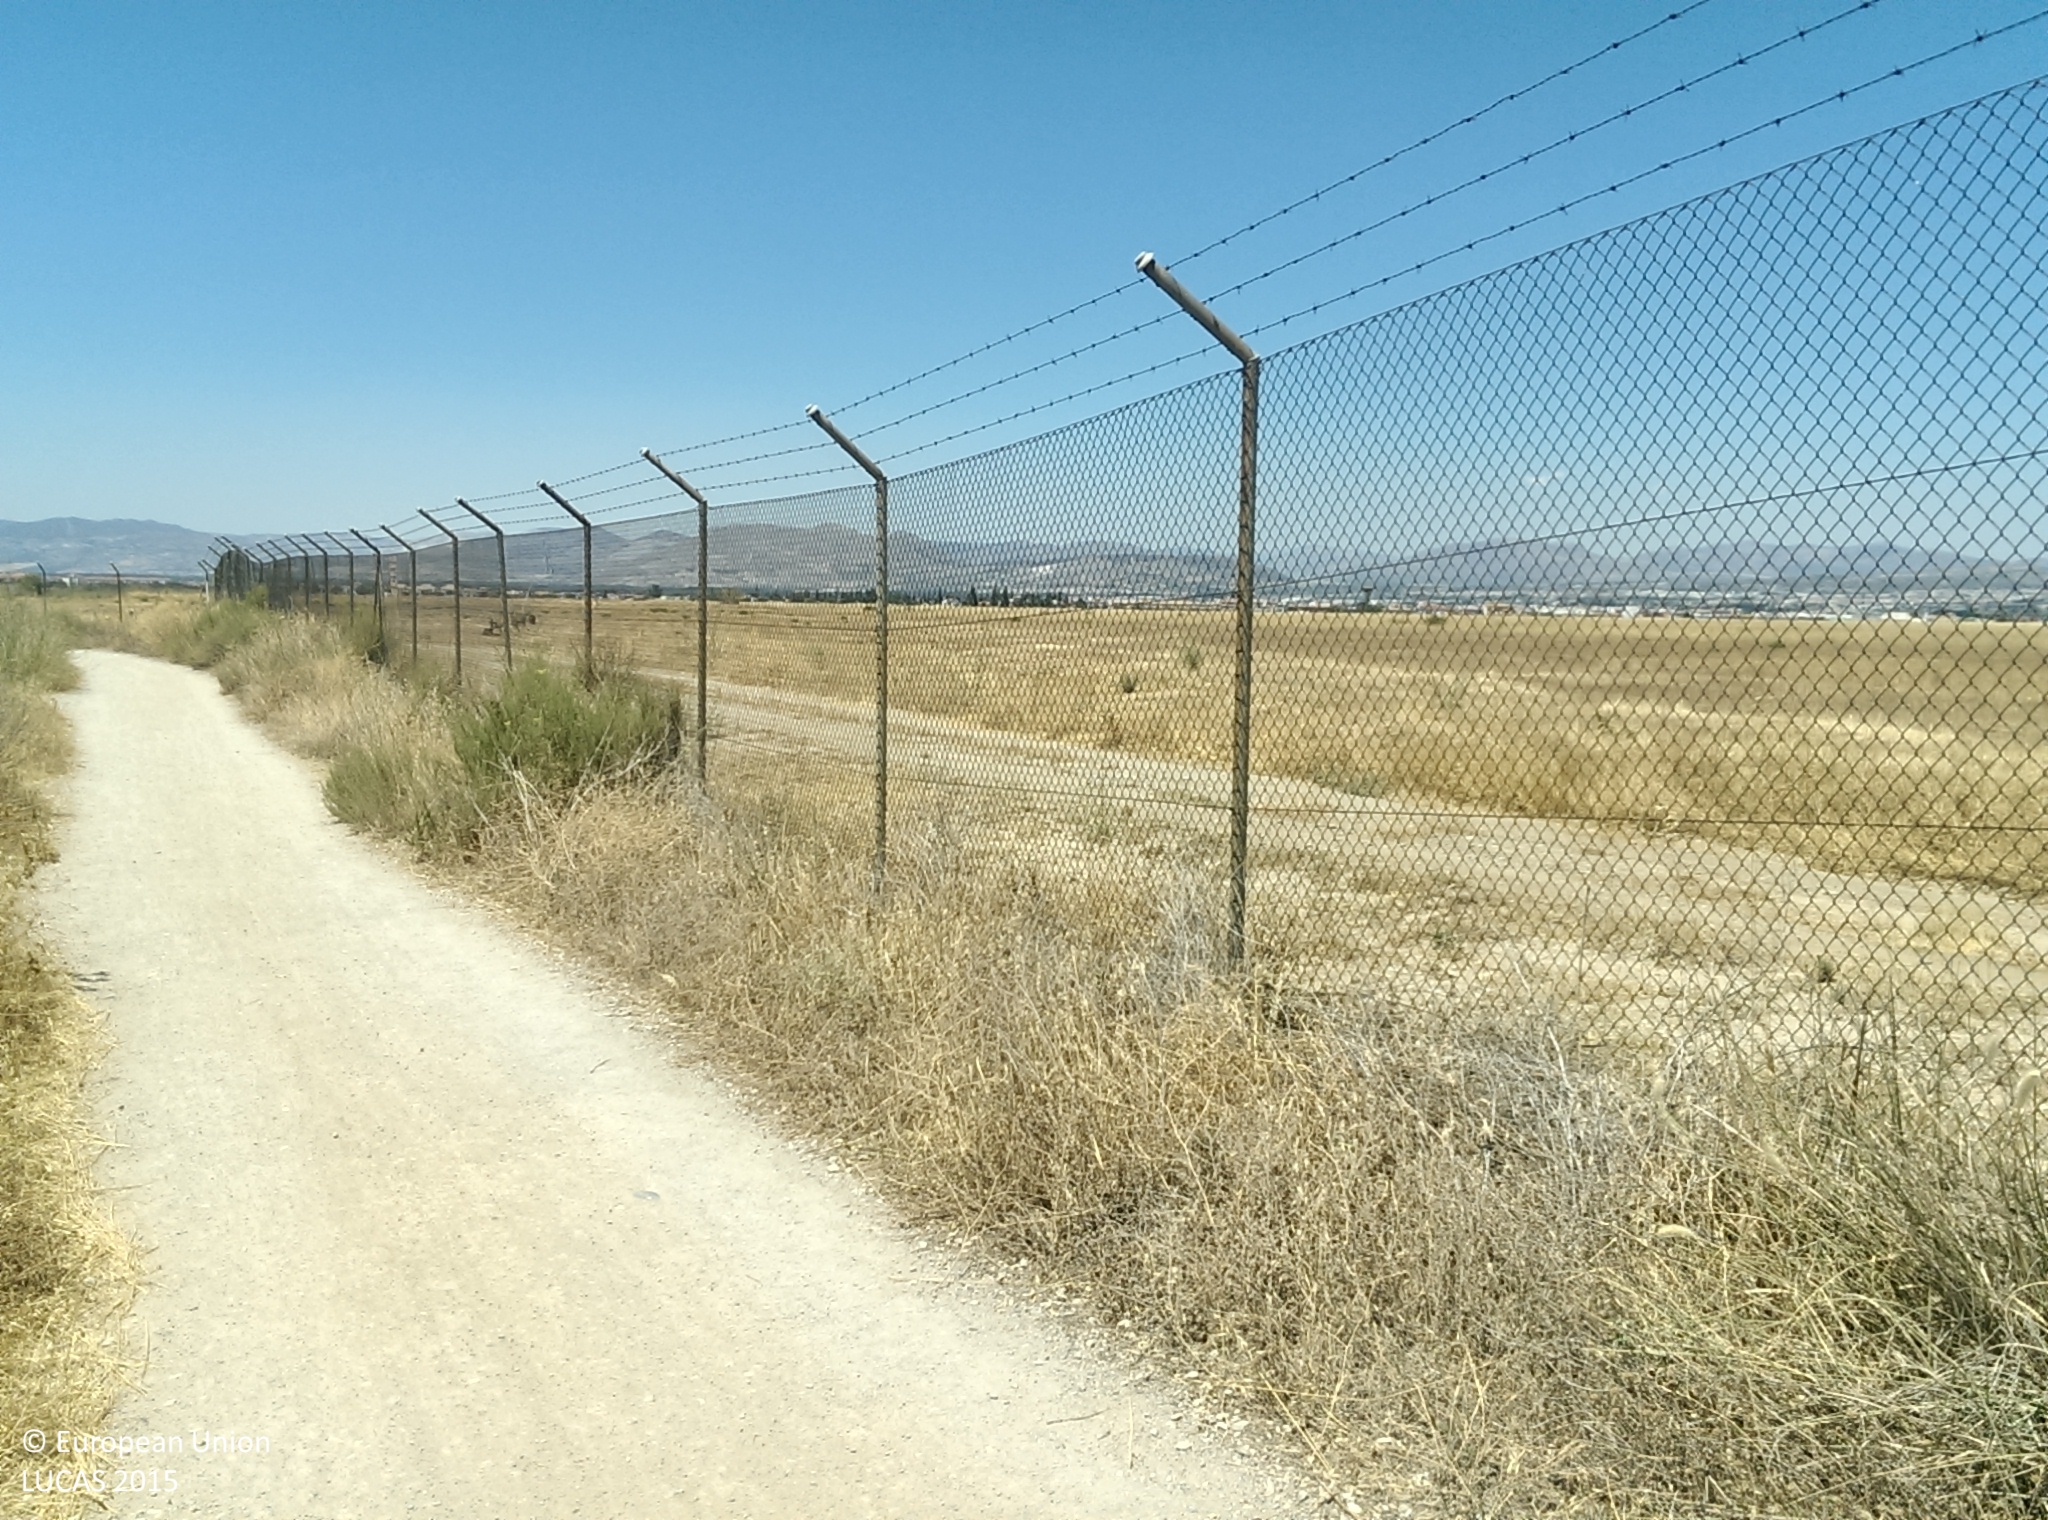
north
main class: Grassland
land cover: Grassland without tree/shrub cover
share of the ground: > 75 %
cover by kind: herbaceous plants 100 %
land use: Air transport
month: July
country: ES
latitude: 37.1267
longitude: -3.6420
